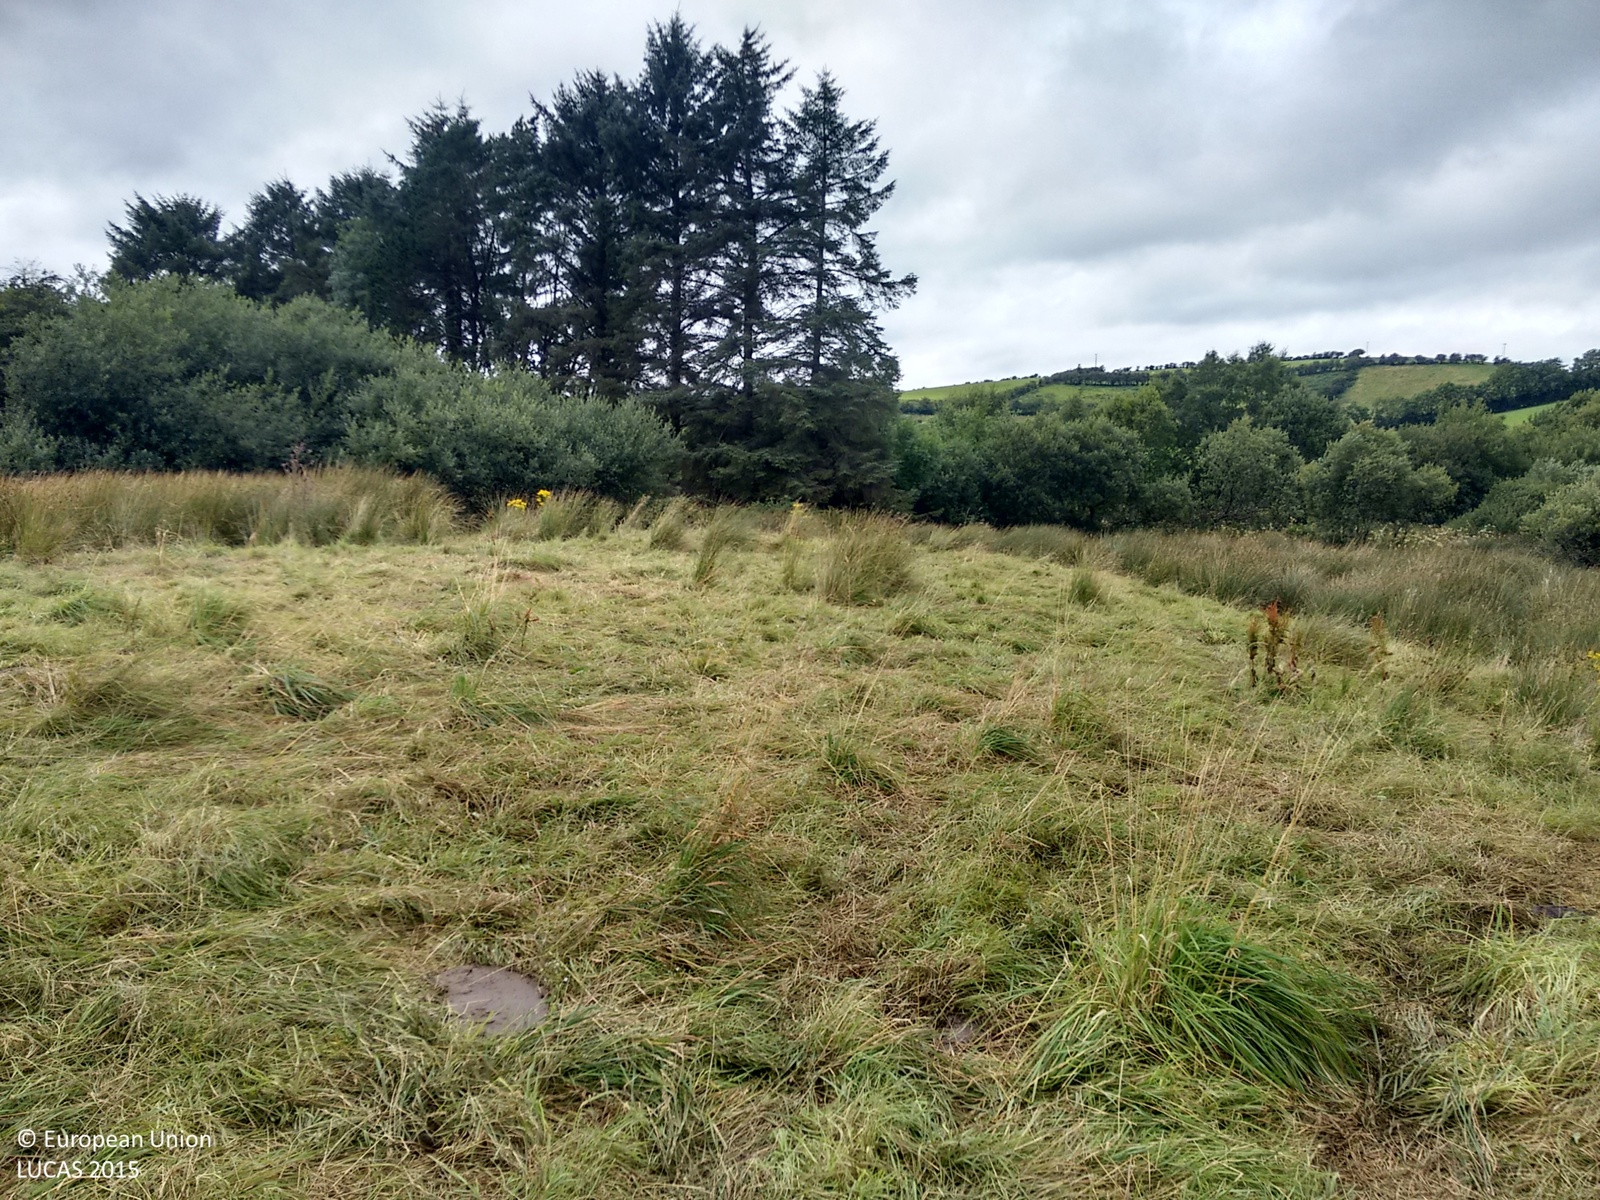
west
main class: Grassland
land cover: Grassland with sparse tree/shrub cover
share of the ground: > 75 %
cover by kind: herbaceous plants 95 %, broadleaved forest trees 5 %
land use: Agriculture (excluding fallow land and kitchen gardens)
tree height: < 5 m
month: August
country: IE
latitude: 54.0901
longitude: -6.8149
